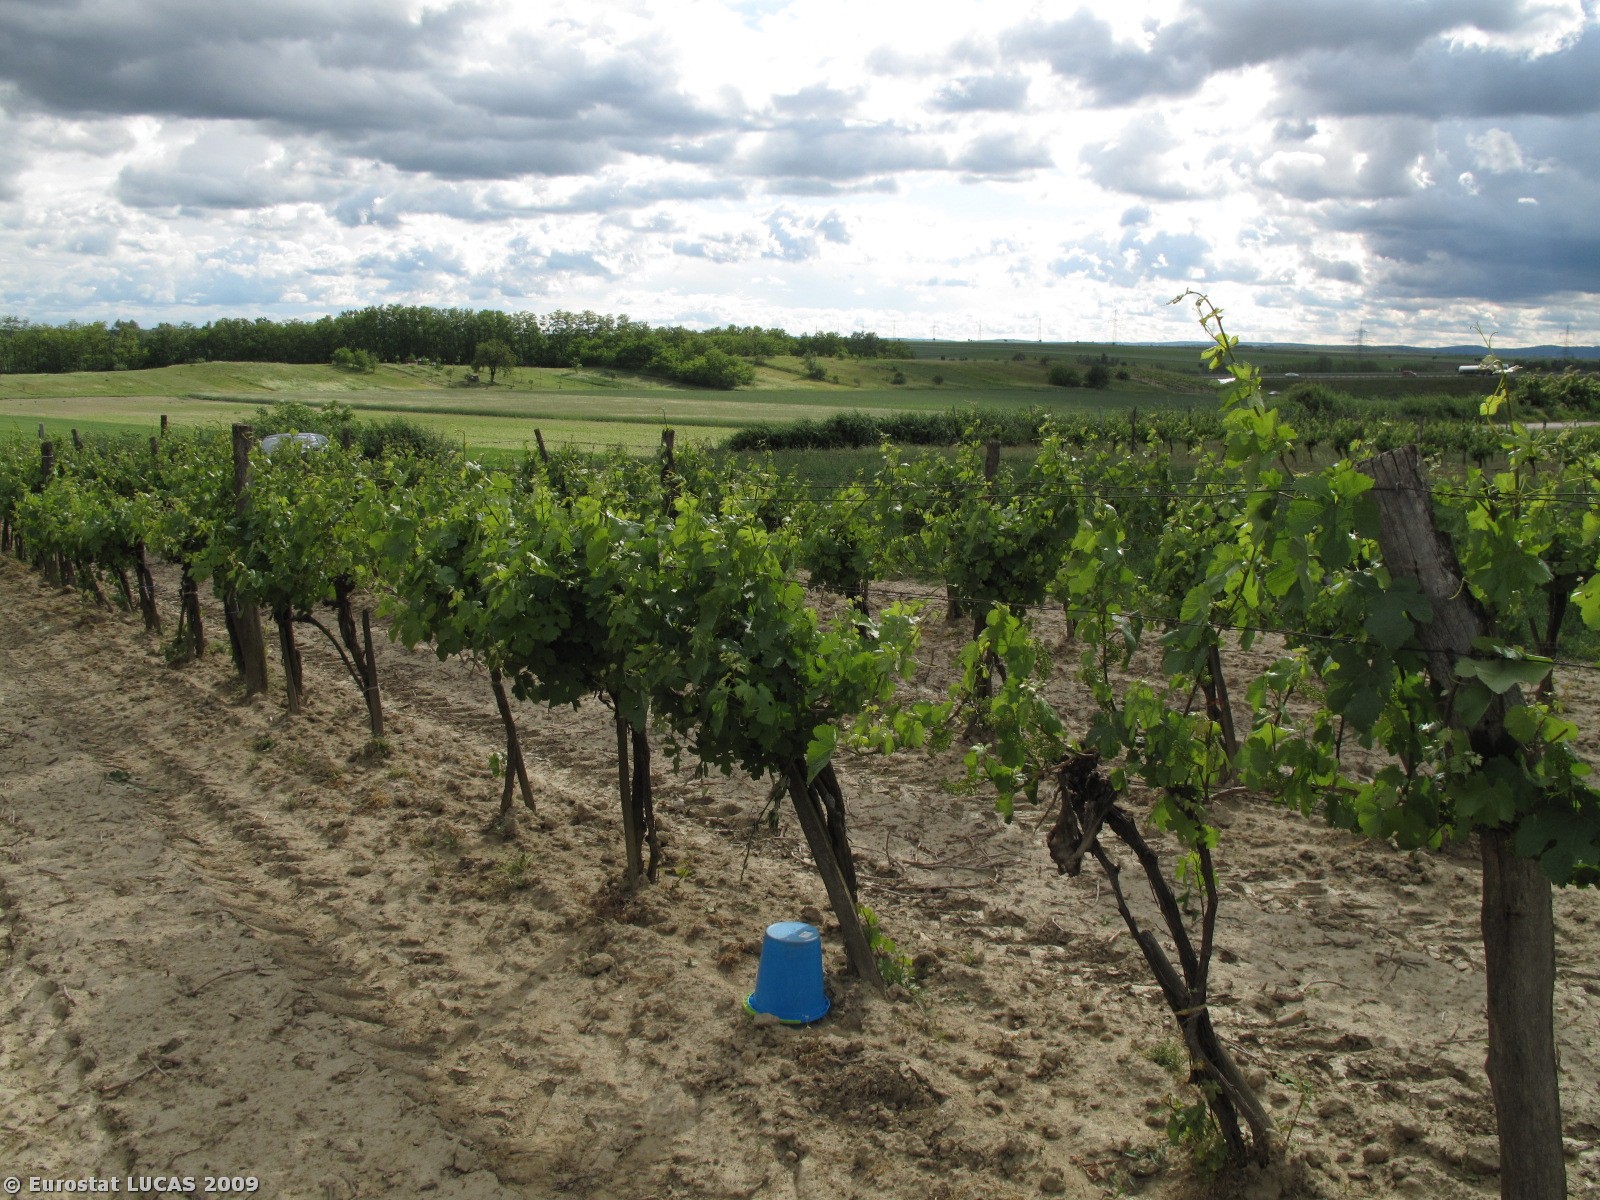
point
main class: Cropland
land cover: Vineyards
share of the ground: 10 - 25 %
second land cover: Bare land
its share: > 75 %
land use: Agriculture (excluding fallow land and kitchen gardens)
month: May
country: AT
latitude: 48.7247
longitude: 16.0540
